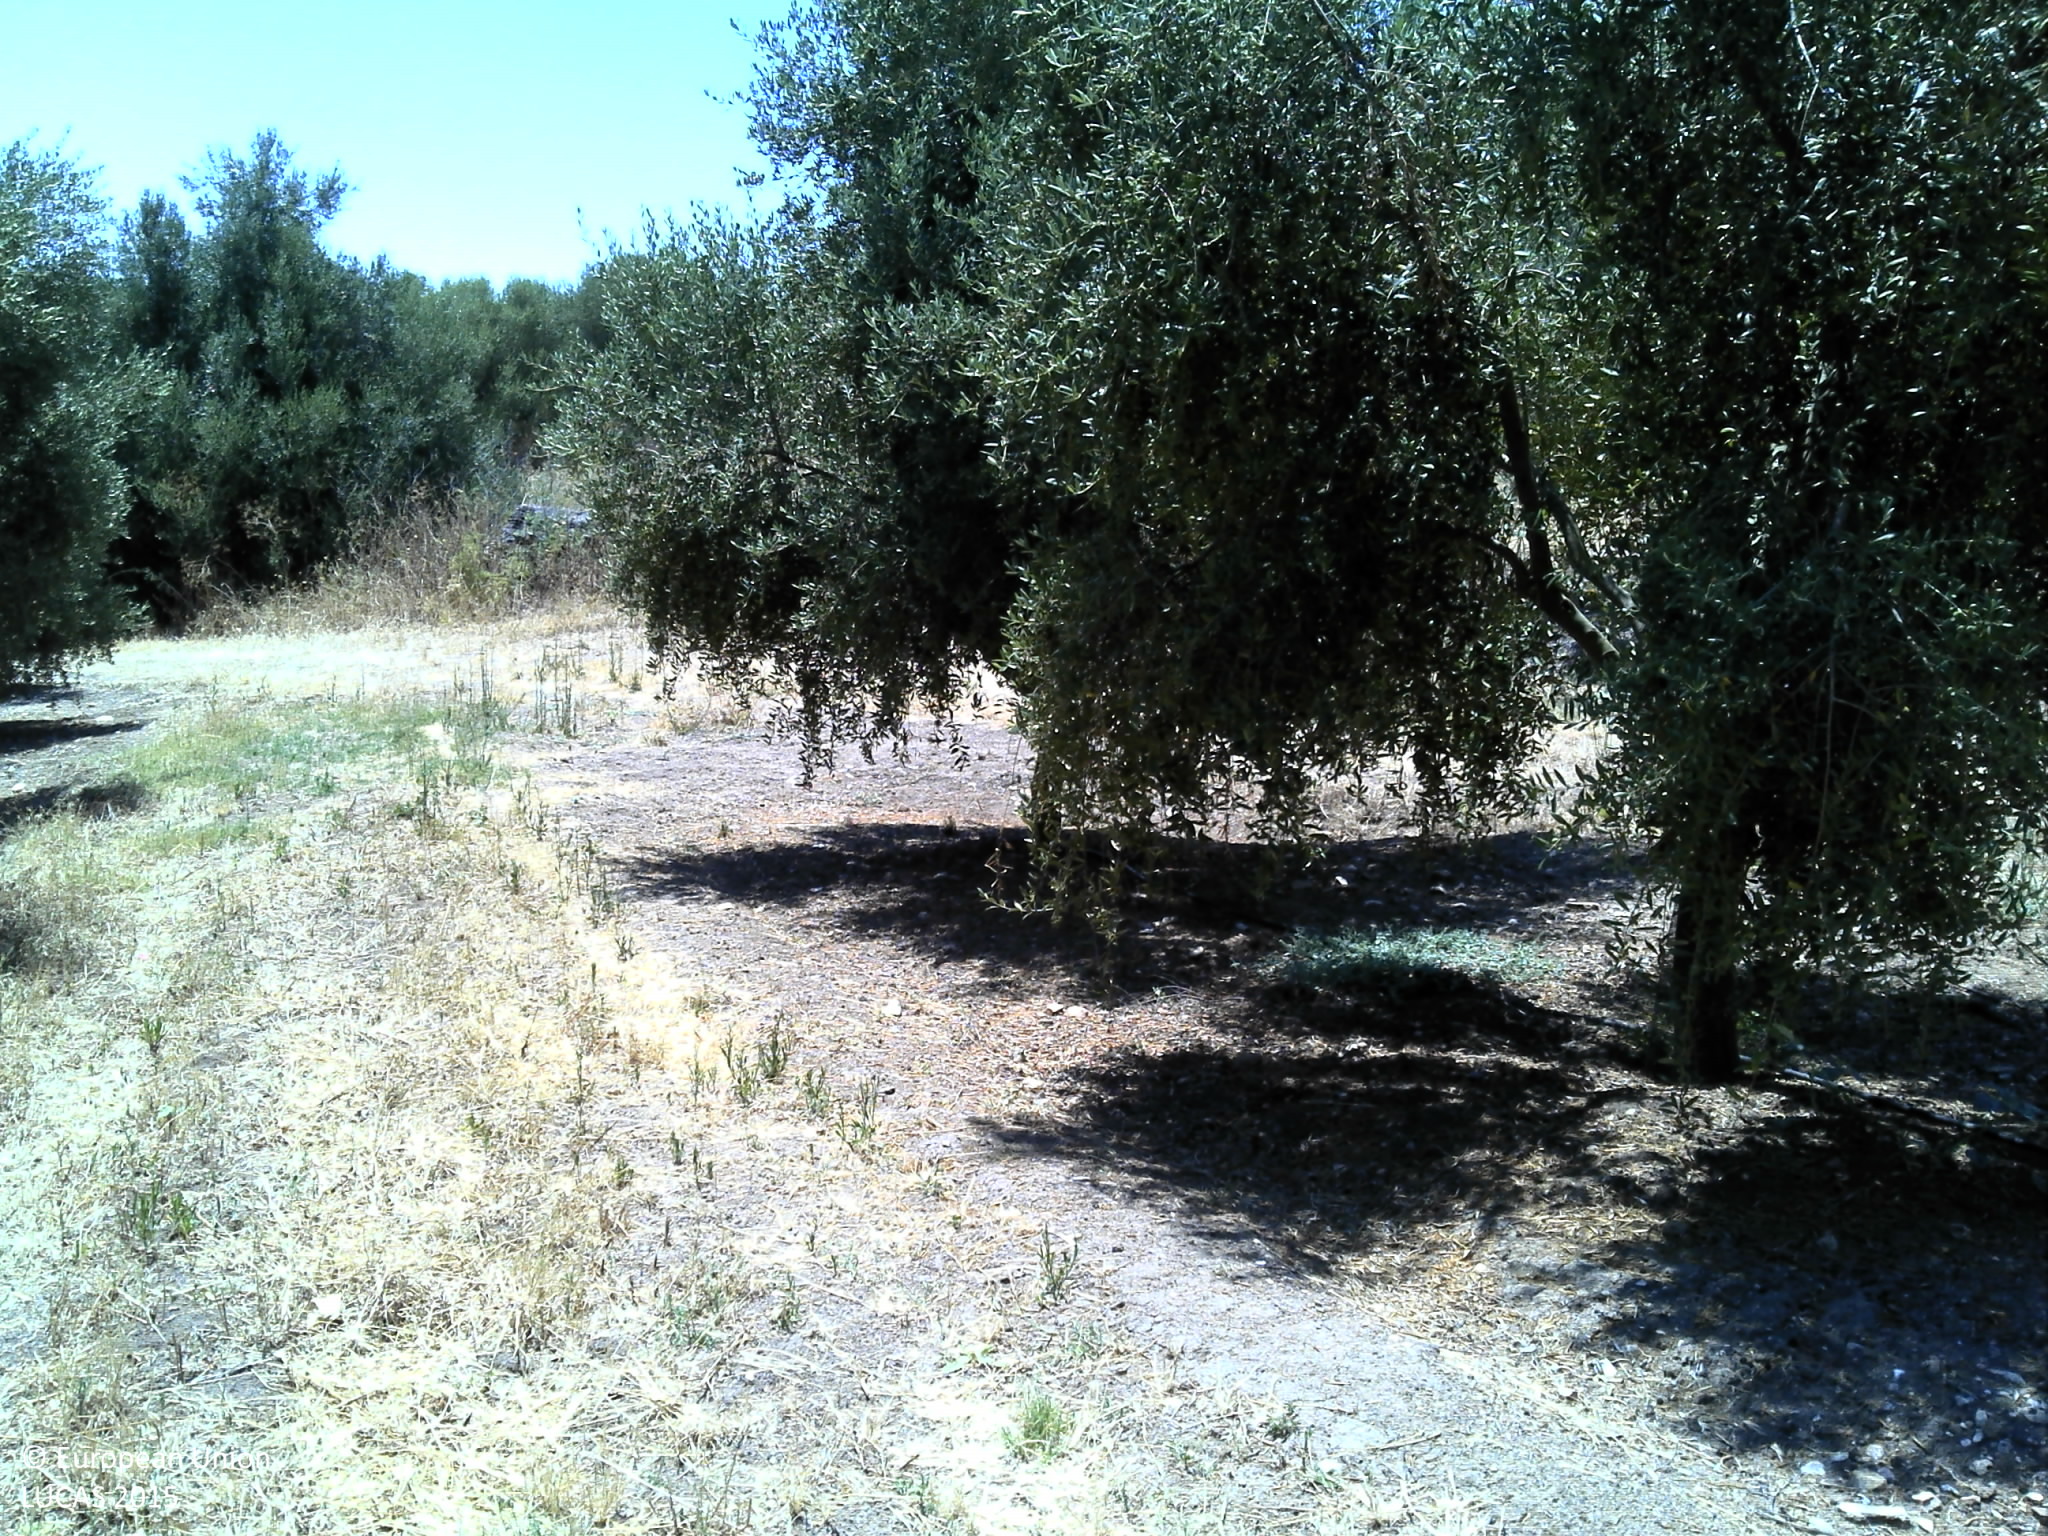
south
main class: Cropland
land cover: Olive groves
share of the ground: 25 - 50 %
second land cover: Grassland without tree/shrub cover
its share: 10 - 25 %
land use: Agriculture (excluding fallow land and kitchen gardens)
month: June
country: PT
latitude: 37.9984
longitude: -7.5924
